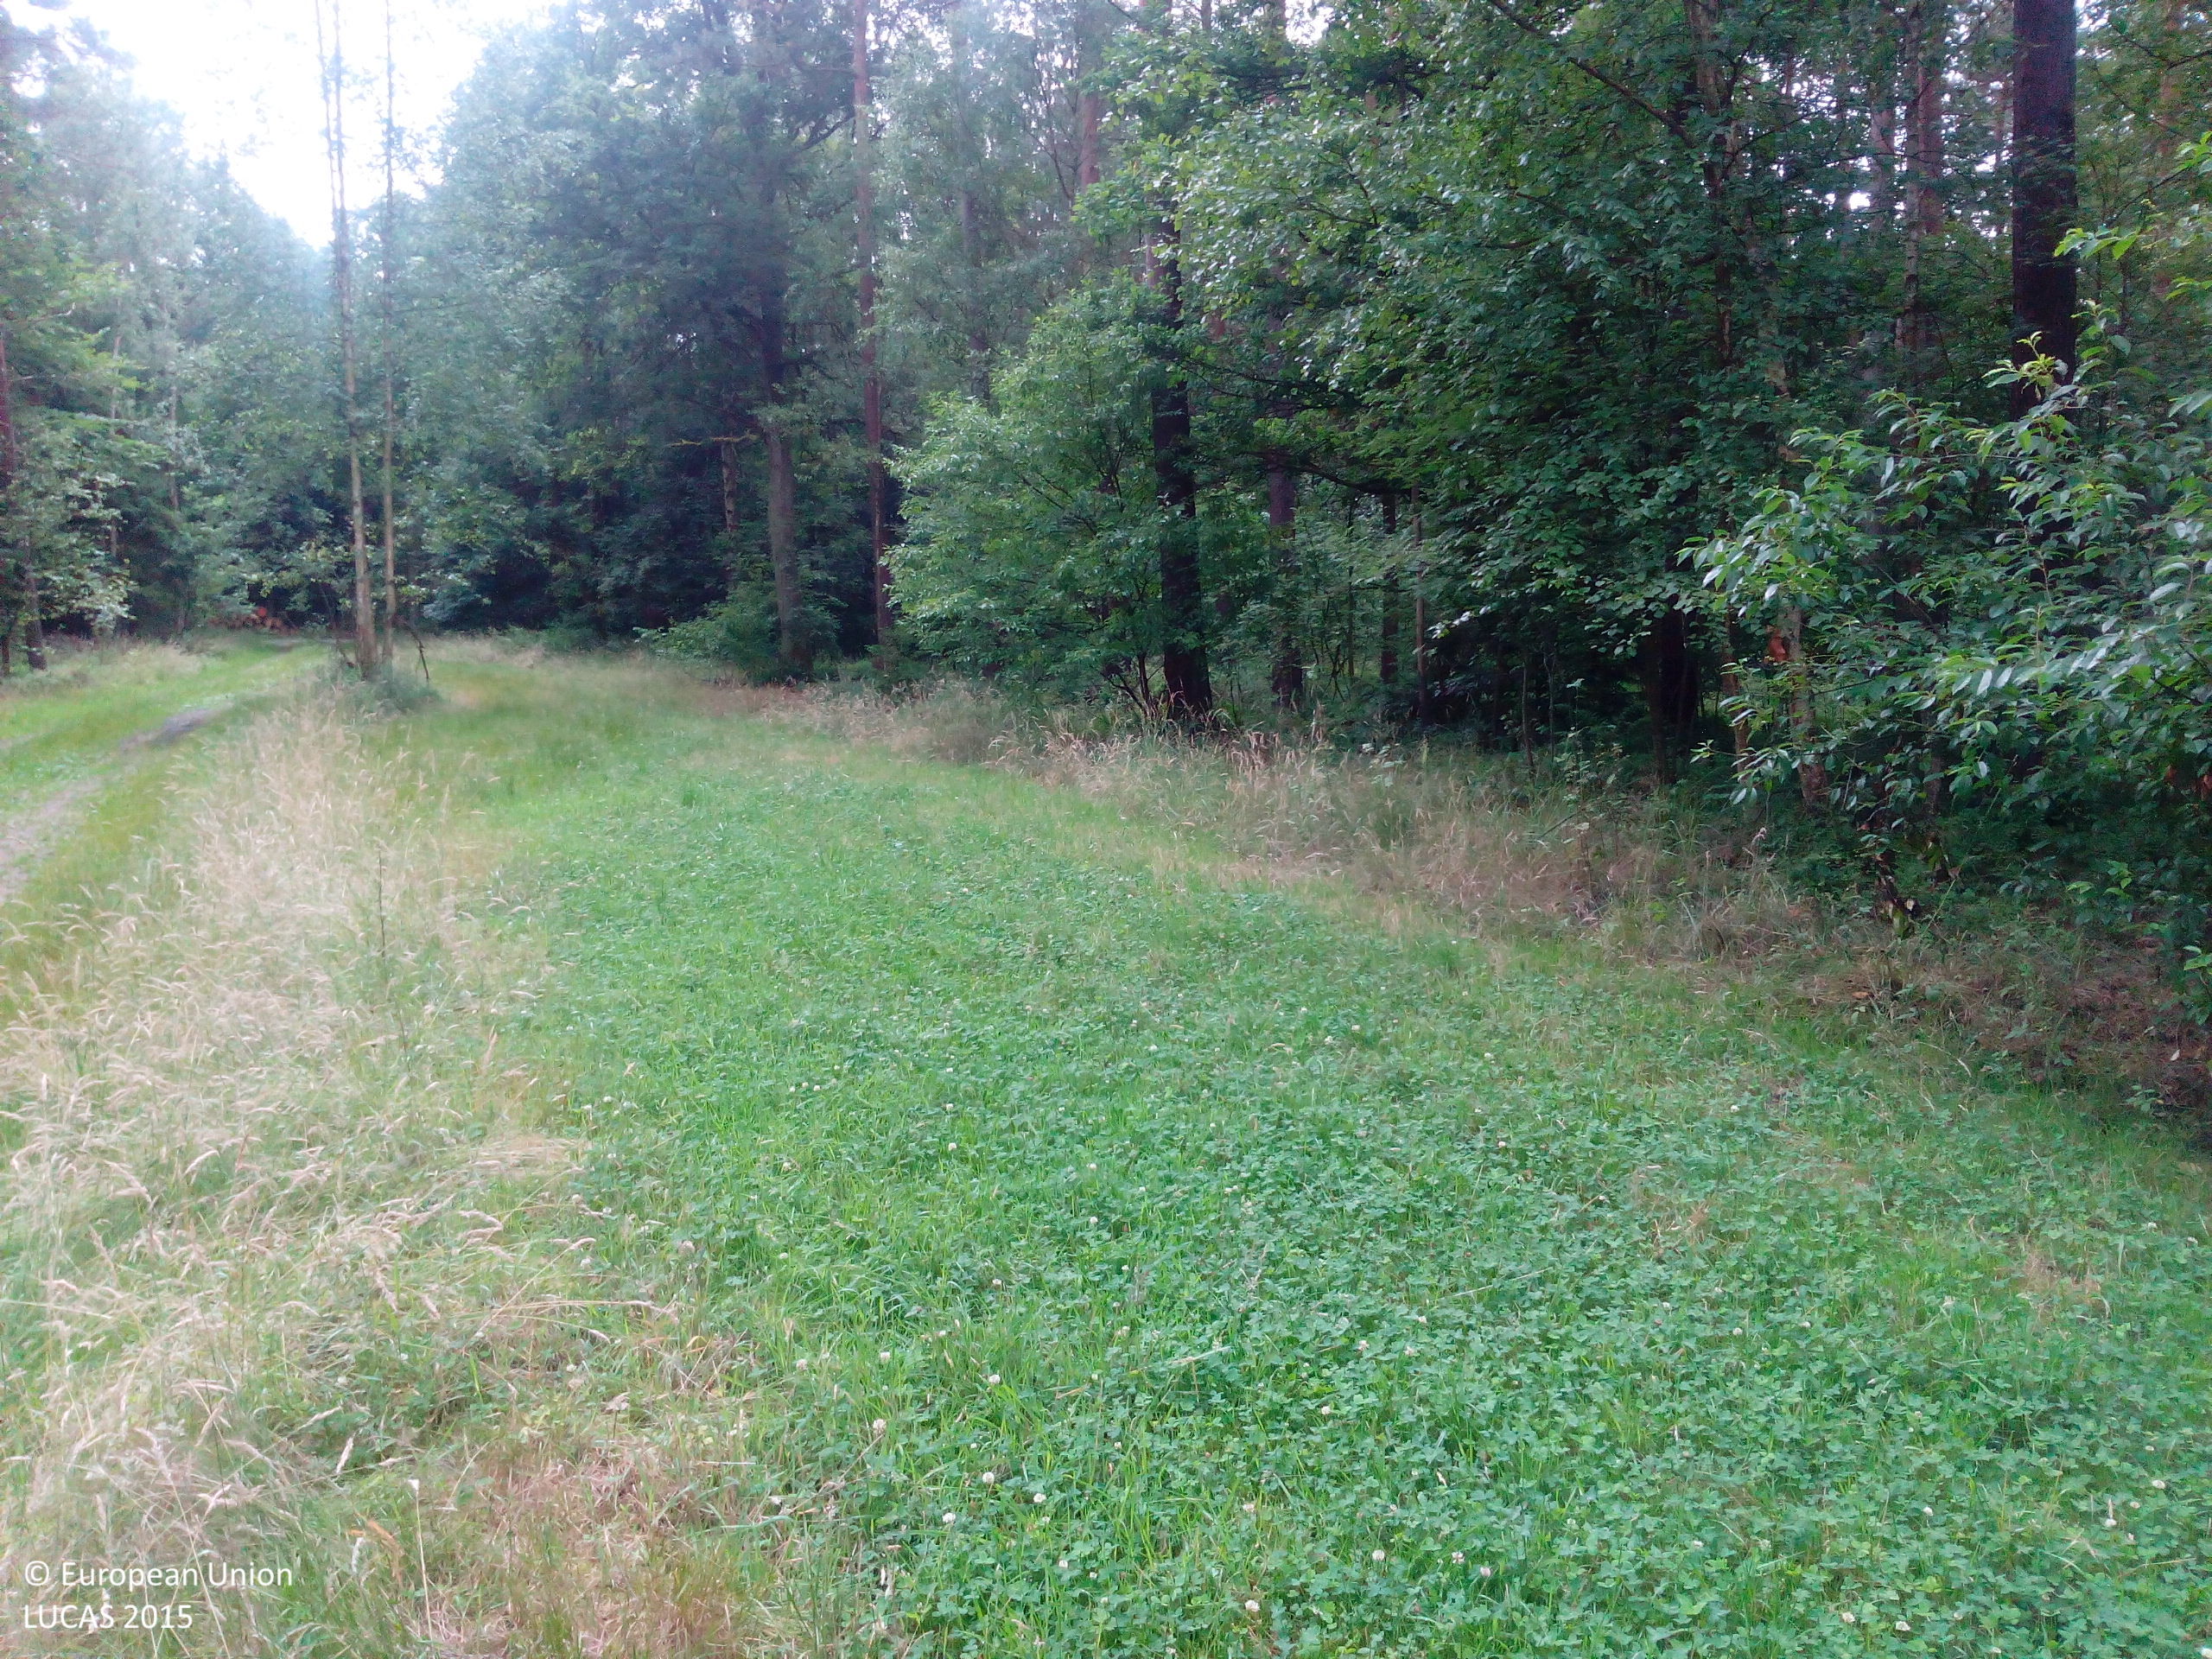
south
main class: Grassland
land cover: Grassland without tree/shrub cover
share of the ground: > 75 %
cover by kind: herbaceous plants 90 %, unconsolidated bare surface 10 %
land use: Road transport
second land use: Forestry
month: July
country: DE
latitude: 52.8444
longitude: 10.3117
